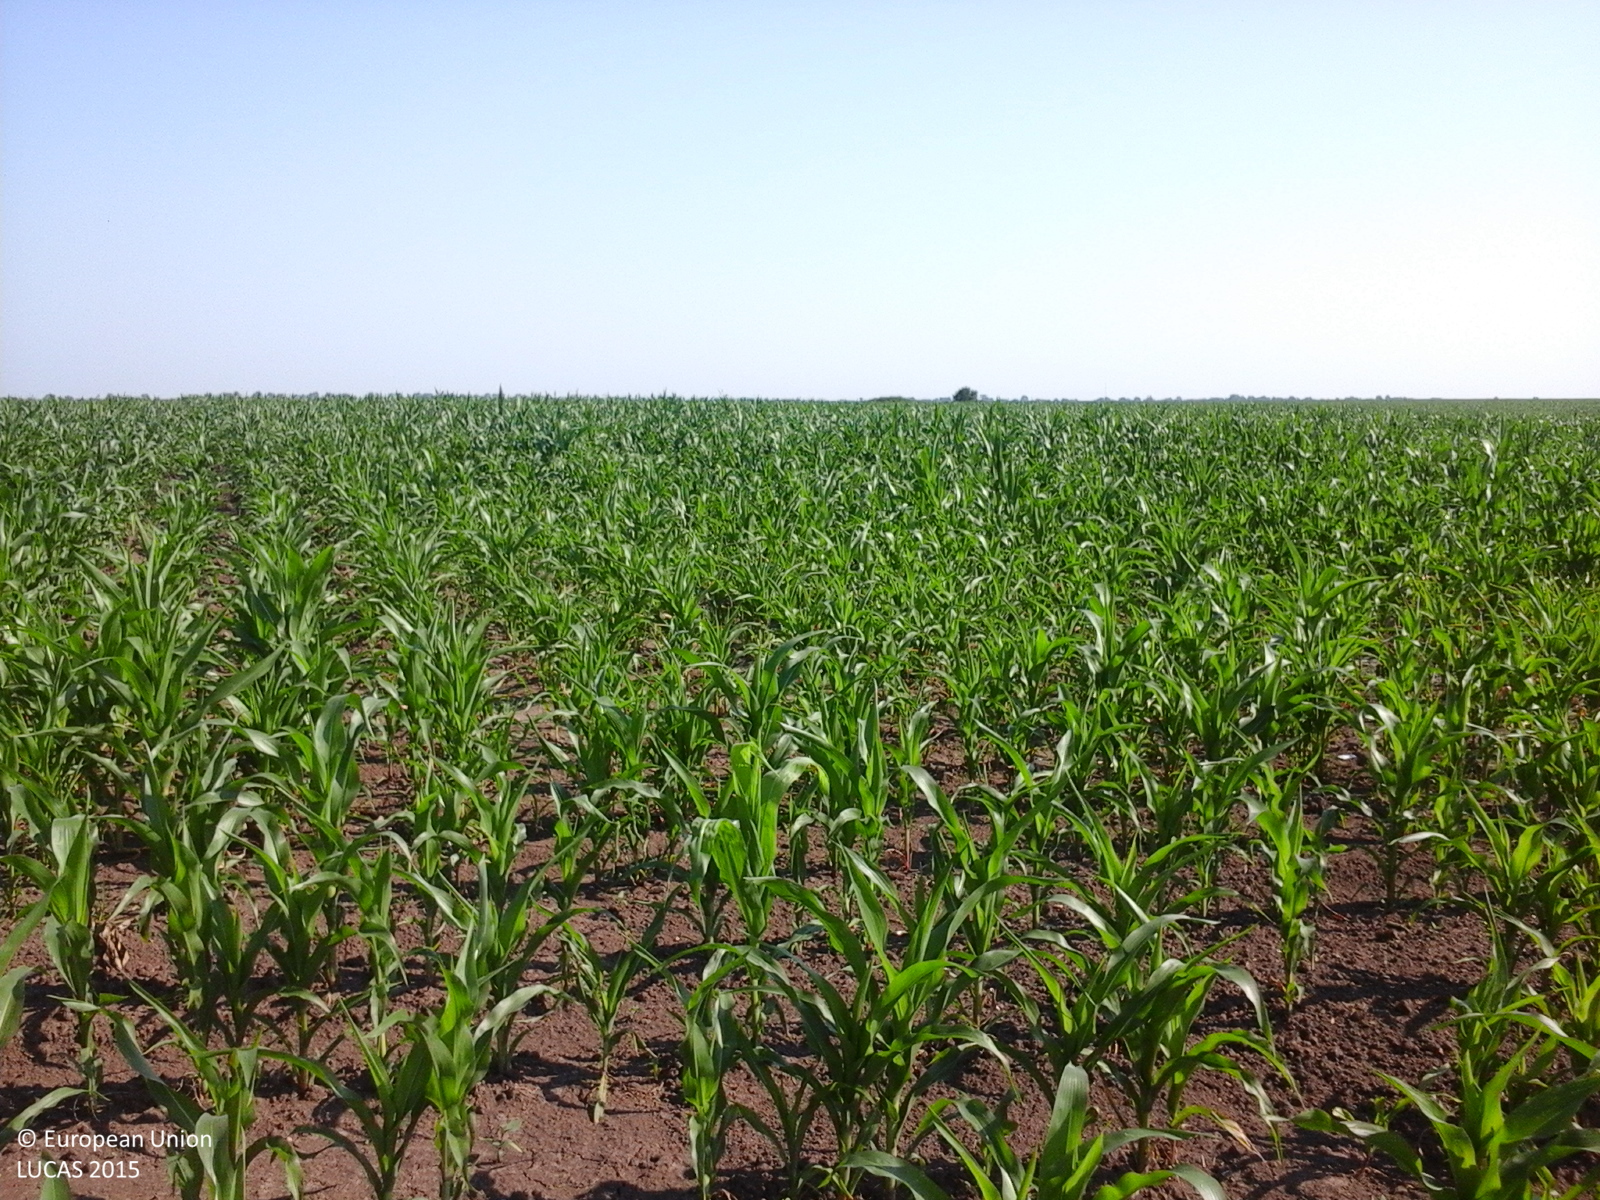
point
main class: Cropland
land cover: Maize
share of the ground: > 75 %
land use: Agriculture (excluding fallow land and kitchen gardens)
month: July
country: RO
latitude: 44.6492
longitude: 24.8446
